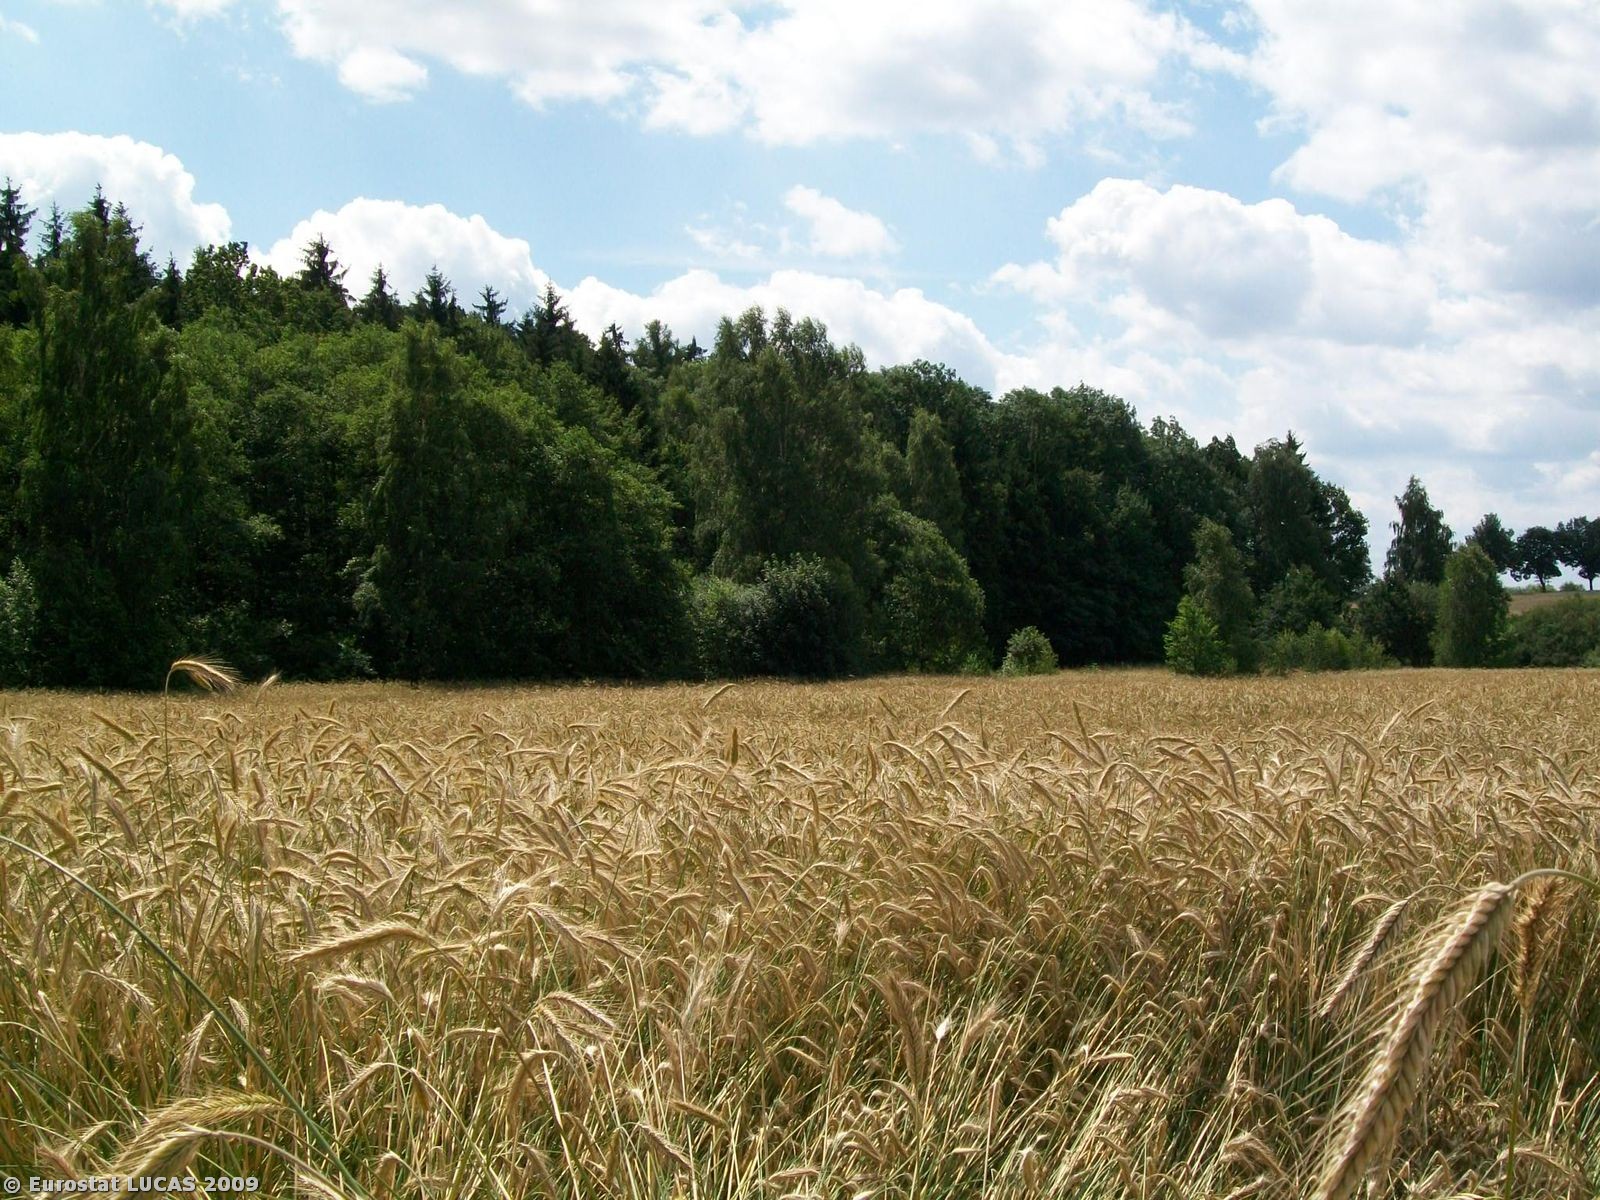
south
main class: Cropland
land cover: Rye
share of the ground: > 75 %
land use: Agriculture (excluding fallow land and kitchen gardens)
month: July
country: PL
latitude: 51.0945
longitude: 15.1580
